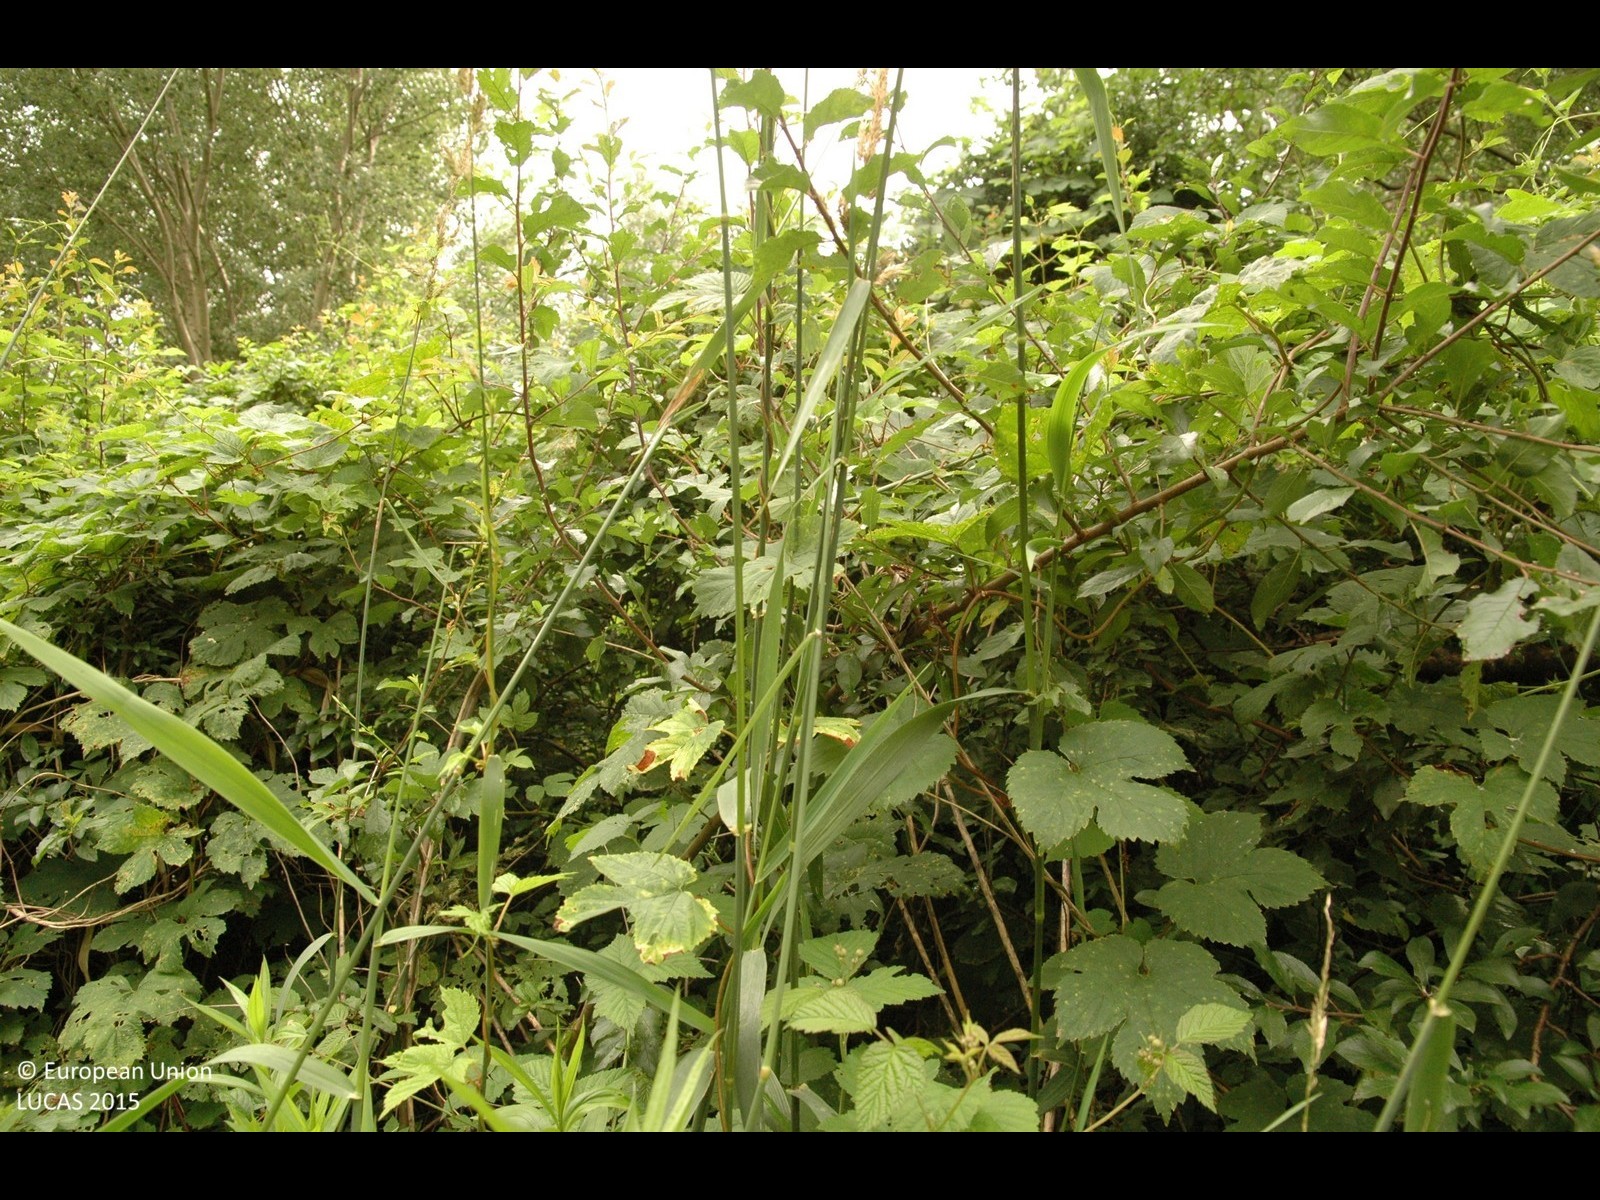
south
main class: Woodland
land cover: Broadleaved woodland
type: floodplain forest
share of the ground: > 75 %
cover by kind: broadleaved forest trees 90 %, shrubs 10 %
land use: Forestry
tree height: > 5 m
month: June
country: HR
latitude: 46.3819
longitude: 16.3063
